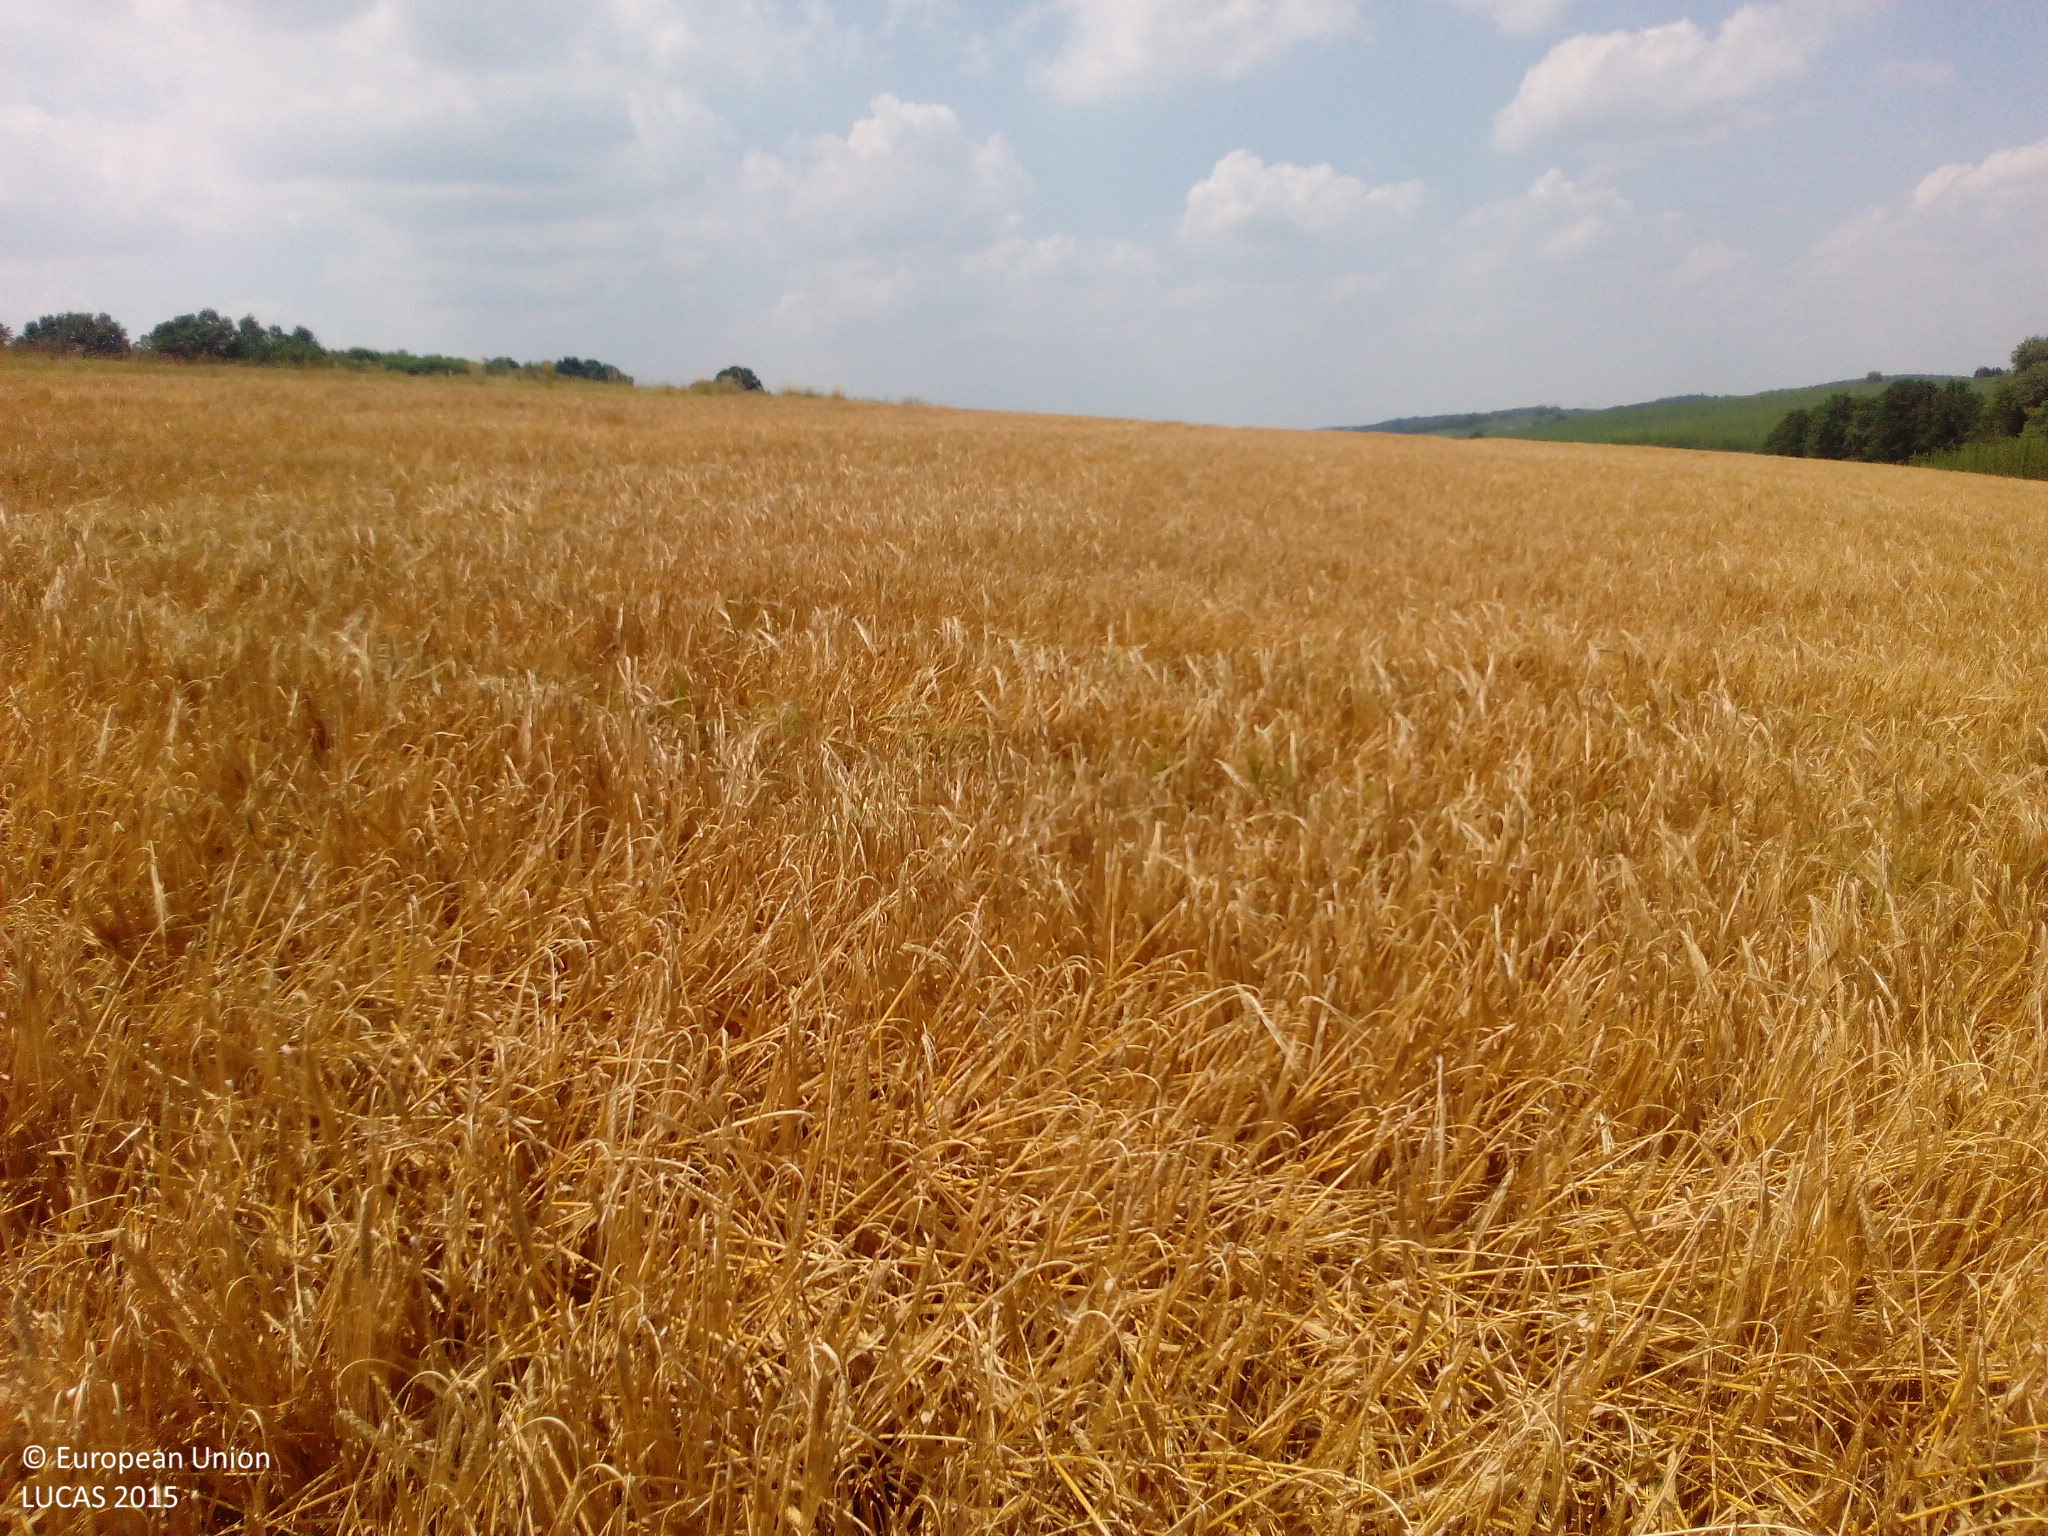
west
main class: Cropland
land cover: Barley
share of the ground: > 75 %
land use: Agriculture (excluding fallow land and kitchen gardens)
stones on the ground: < 10 %
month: July
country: DE
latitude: 48.7648
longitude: 11.9176
